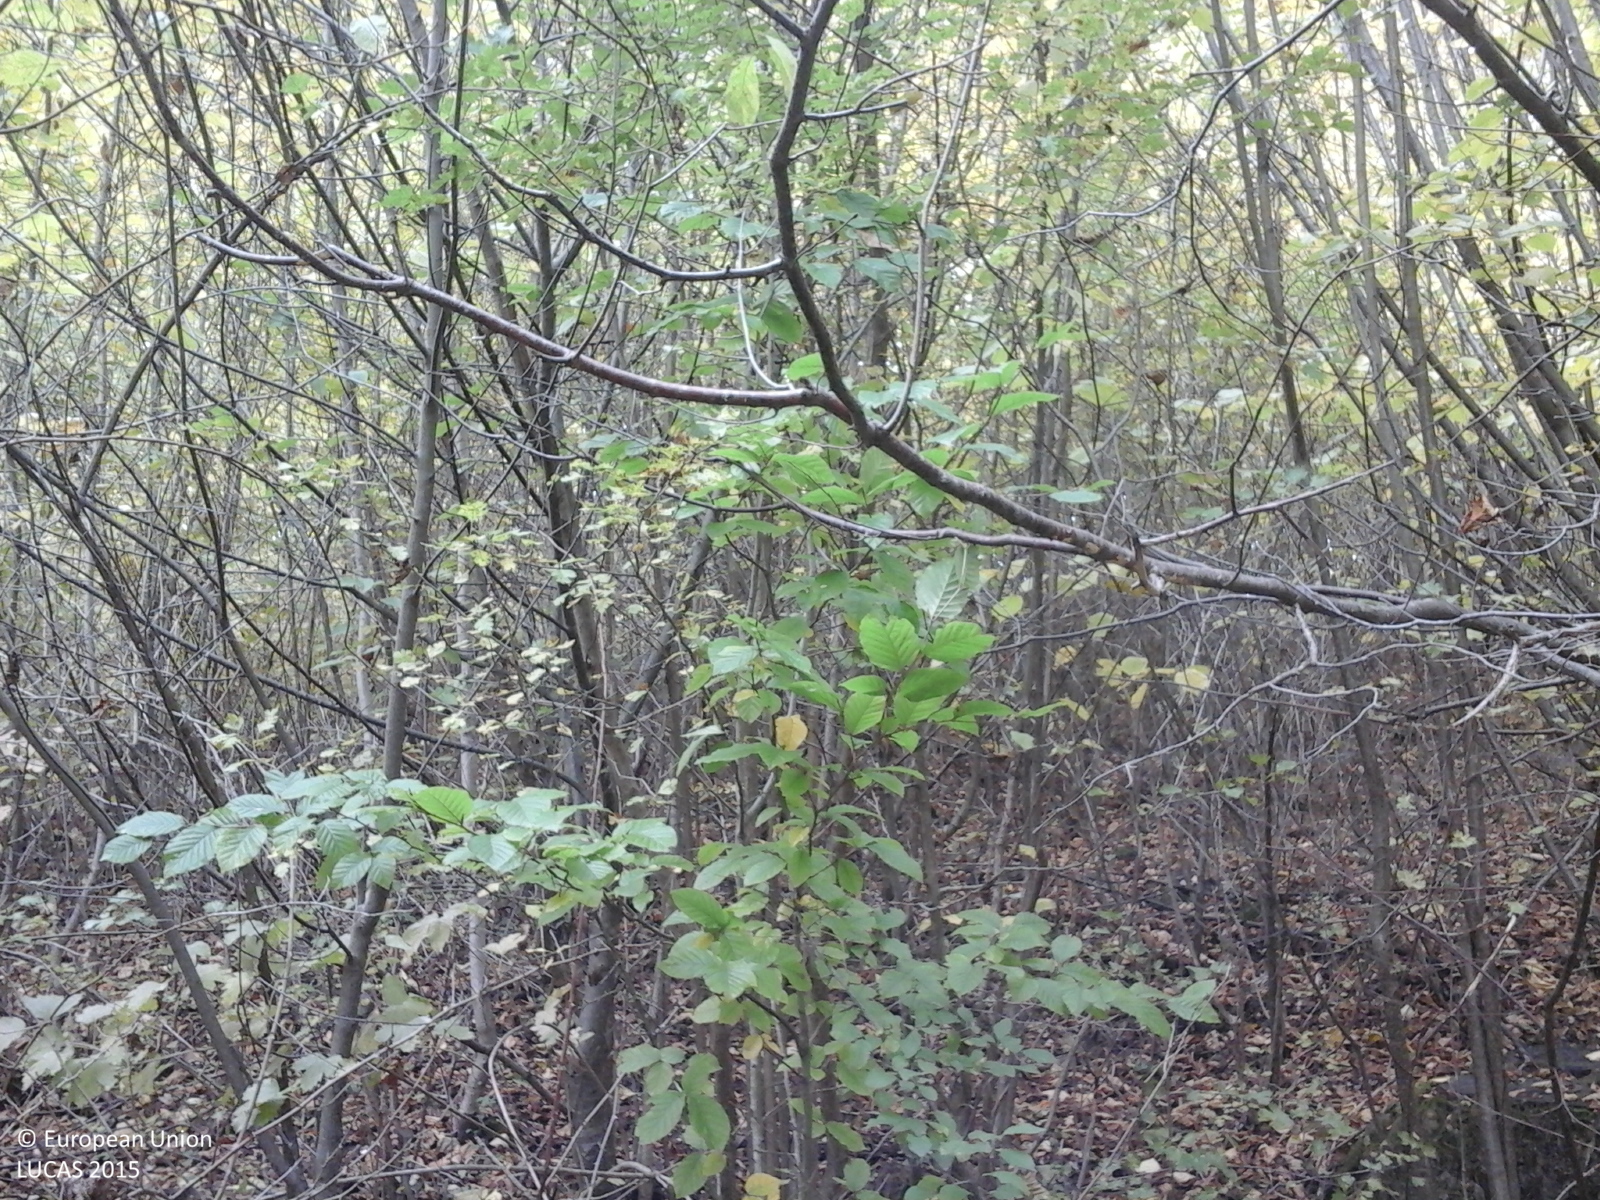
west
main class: Woodland
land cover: Broadleaved woodland
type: beech forest
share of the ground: > 75 %
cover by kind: broadleaved forest trees 100 %
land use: Forestry
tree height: > 5 m
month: October
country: RO
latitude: 46.4546
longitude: 25.4041
